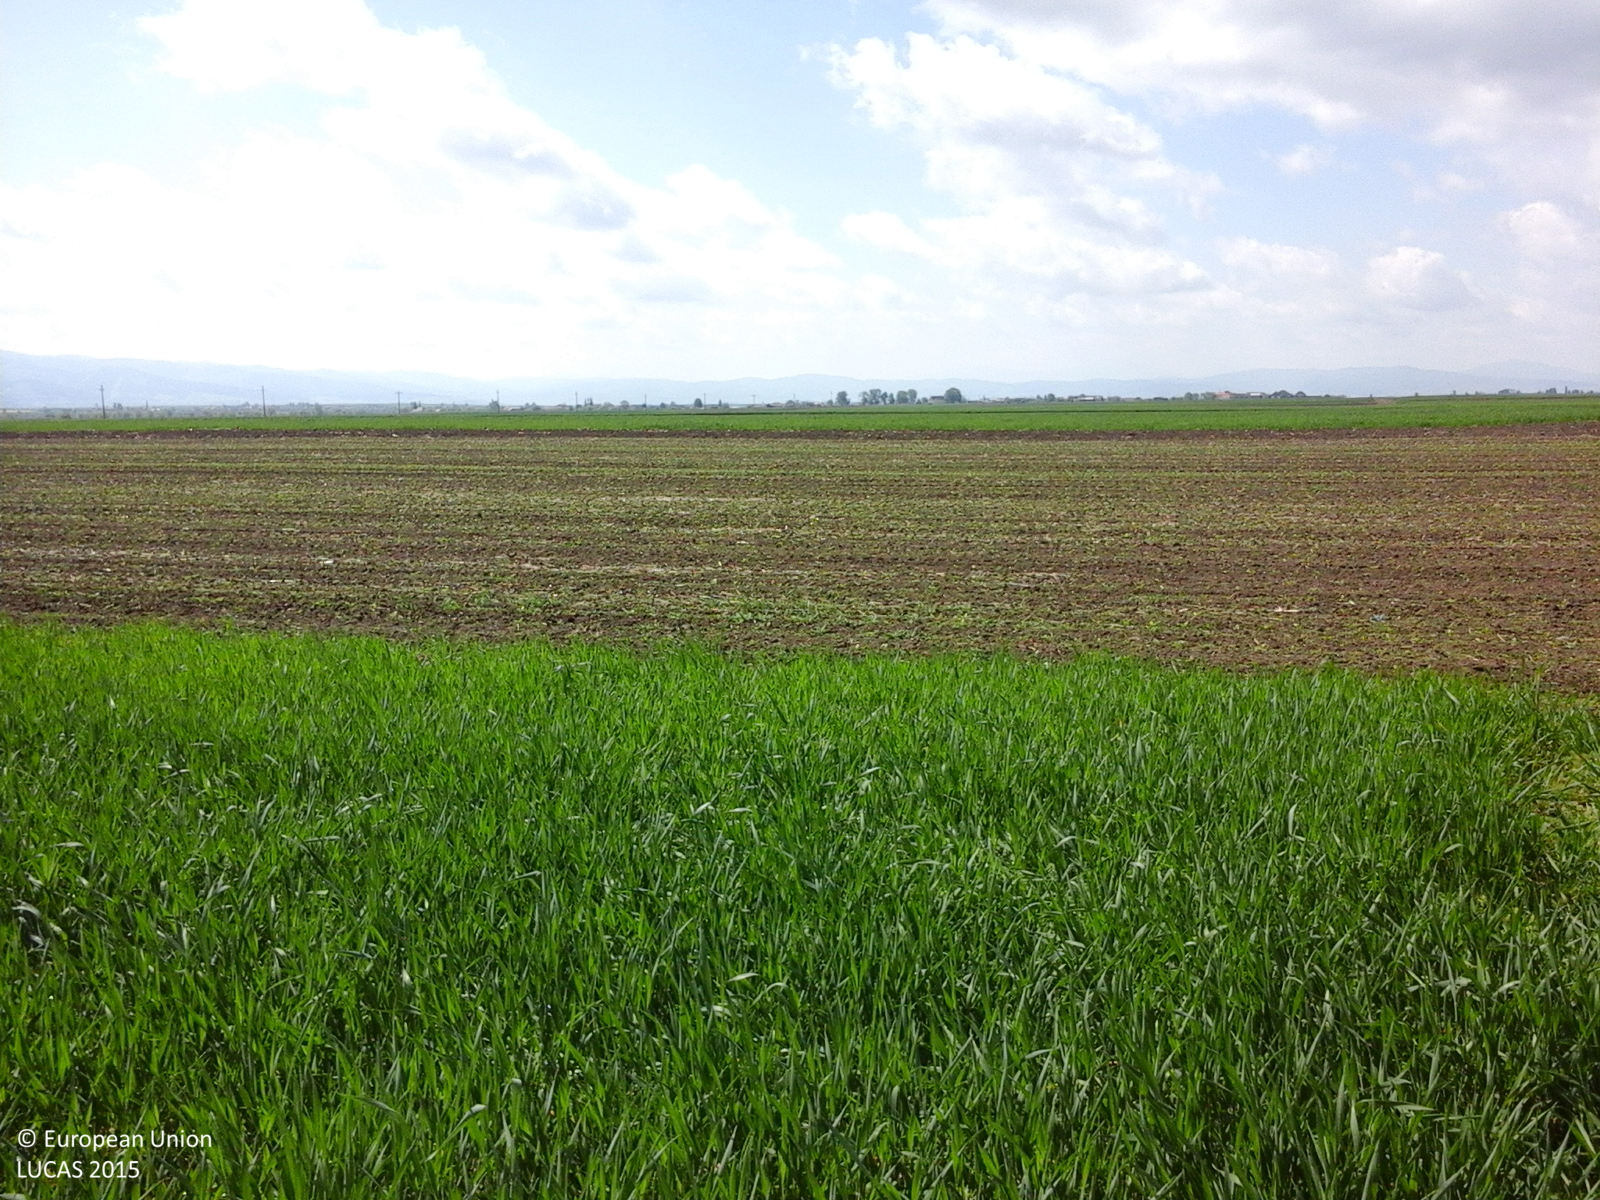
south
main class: Cropland
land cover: Common wheat
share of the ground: > 75 %
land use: Agriculture (excluding fallow land and kitchen gardens)
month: May
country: RO
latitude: 45.9605
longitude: 26.1330
